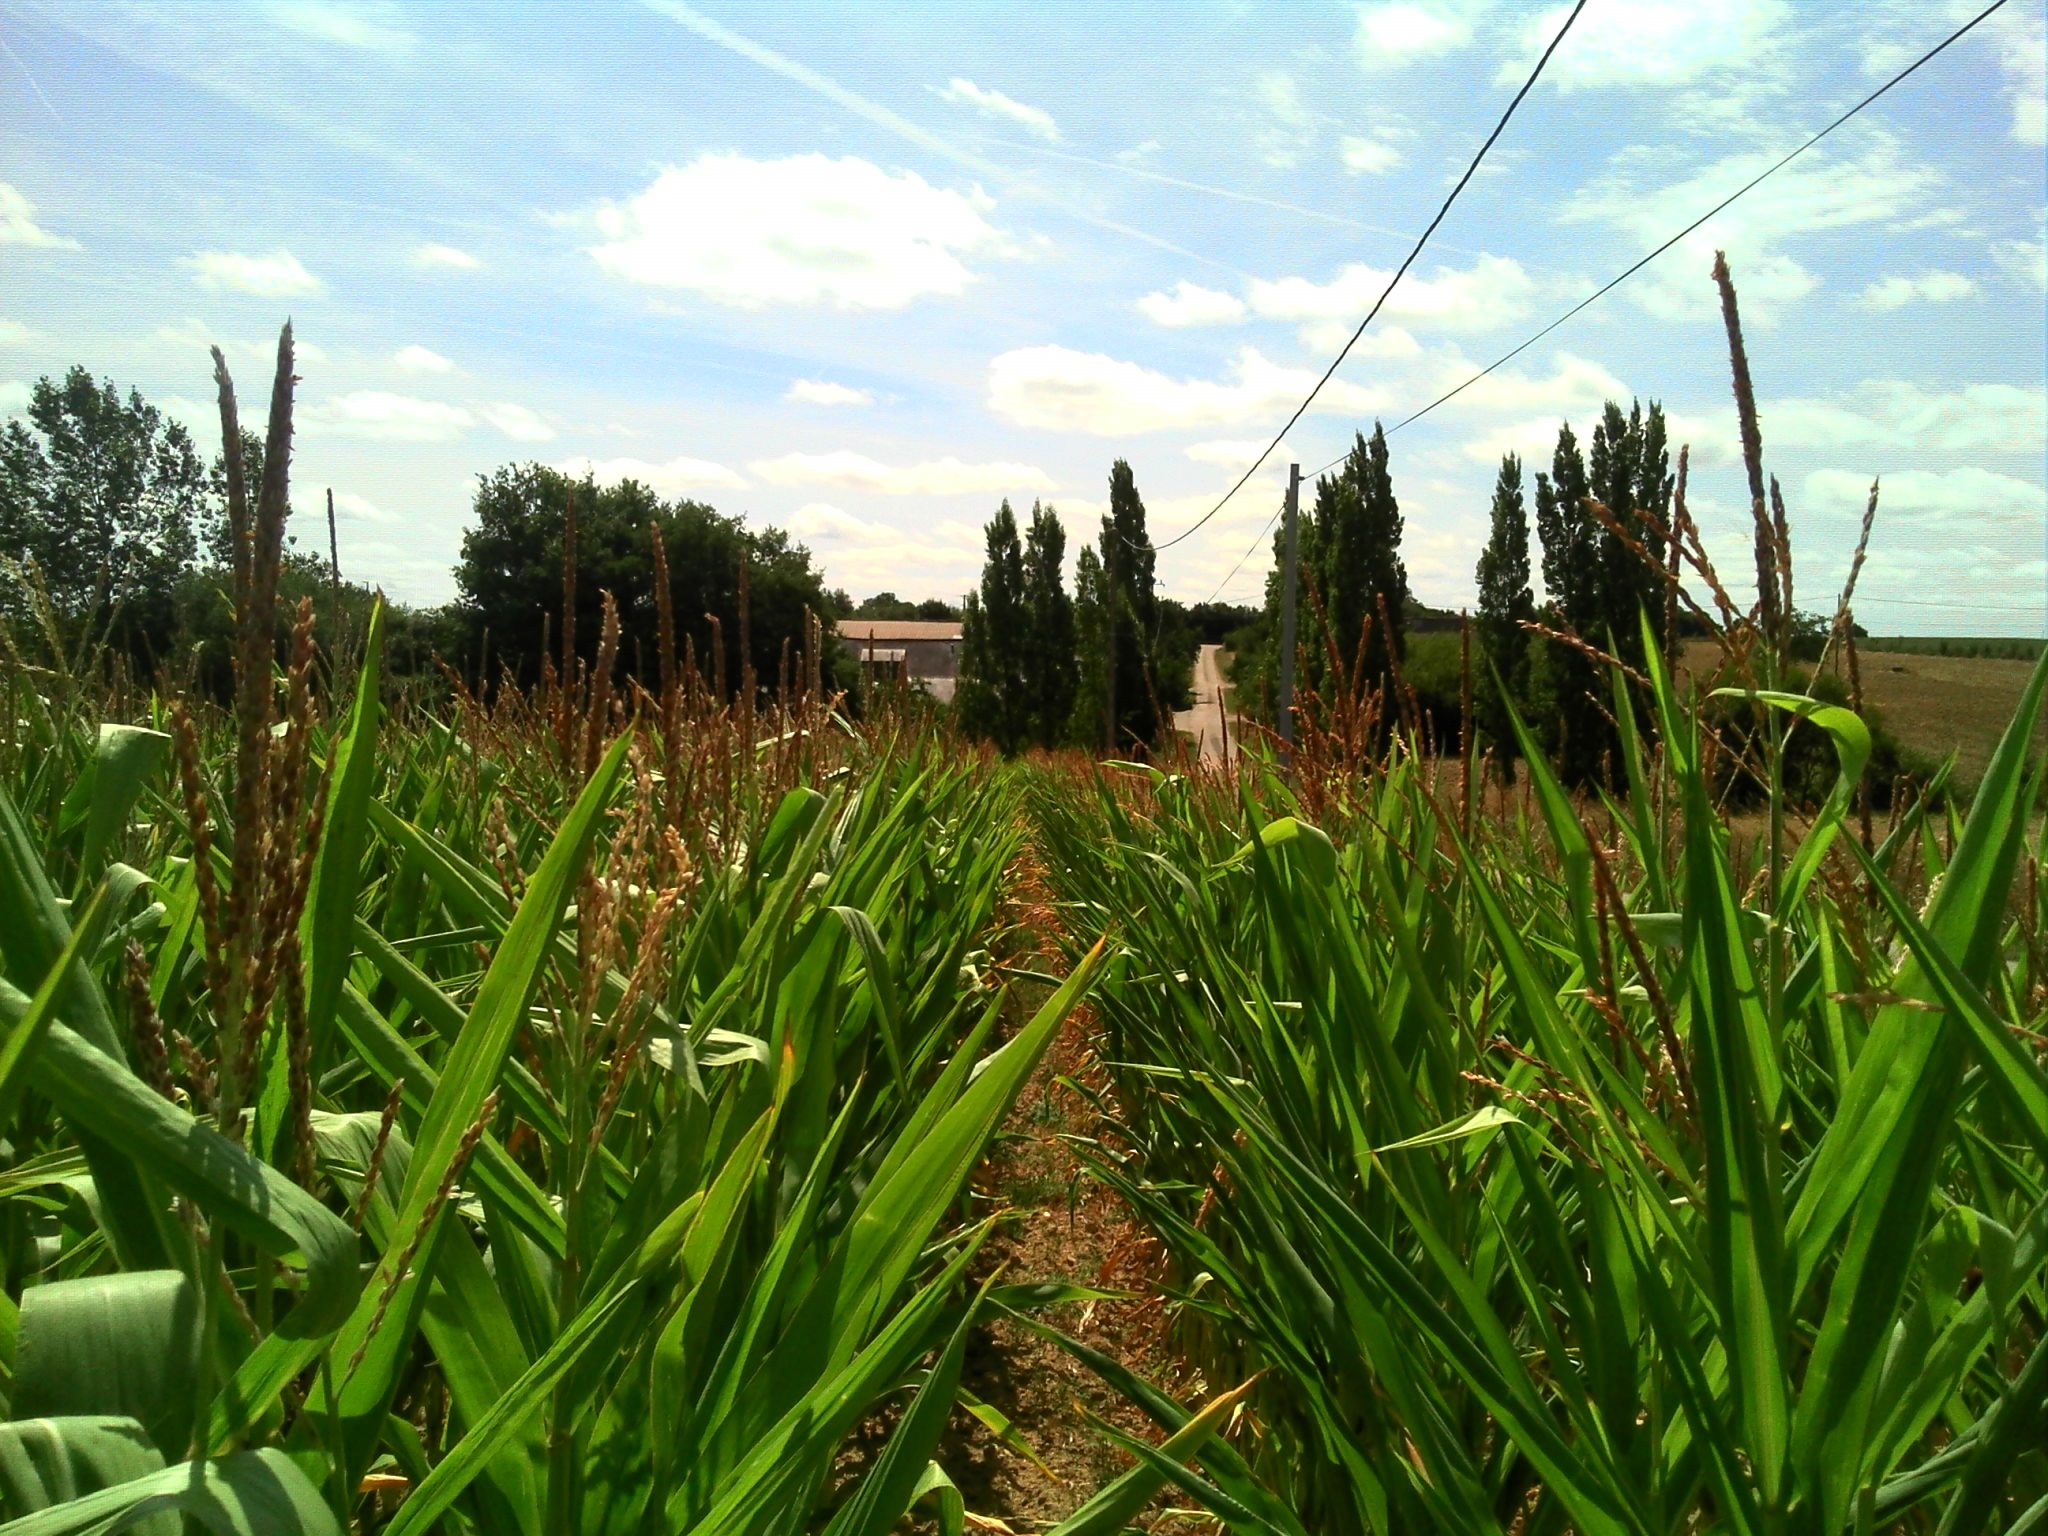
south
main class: Cropland
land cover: Maize
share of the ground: > 75 %
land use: Agriculture (excluding fallow land and kitchen gardens)
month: August
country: FR
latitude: 47.8206
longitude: -1.1390
